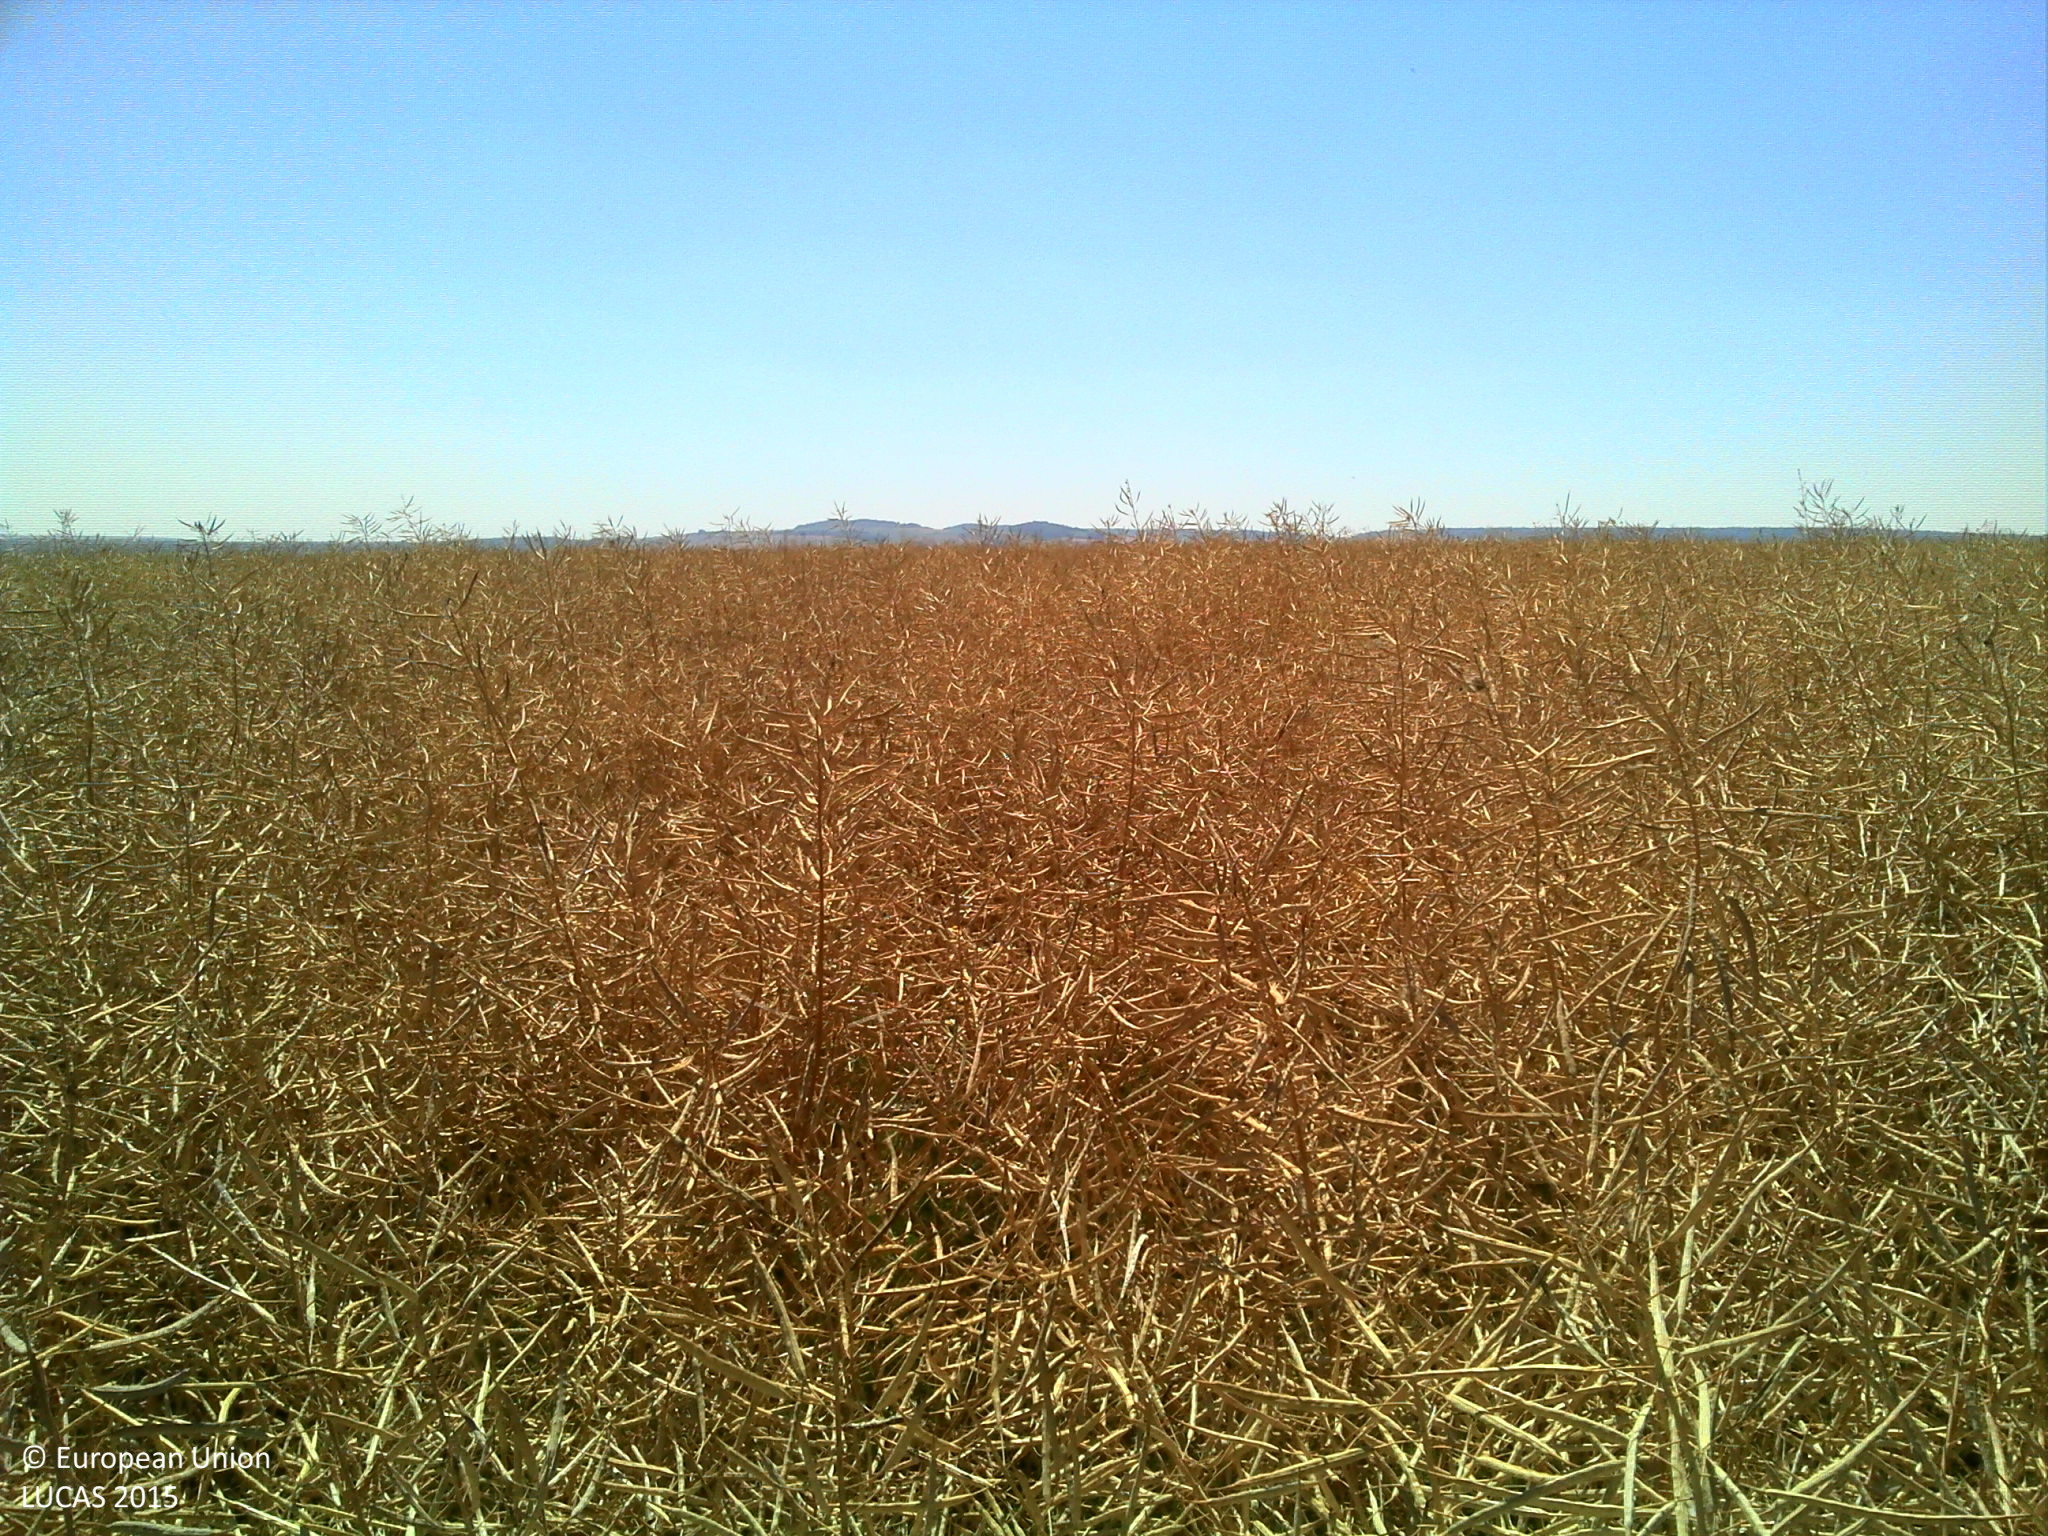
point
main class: Cropland
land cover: Rape and turnip rape
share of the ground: > 75 %
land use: Agriculture (excluding fallow land and kitchen gardens)
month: July
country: FR
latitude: 48.9125
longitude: 6.1383
